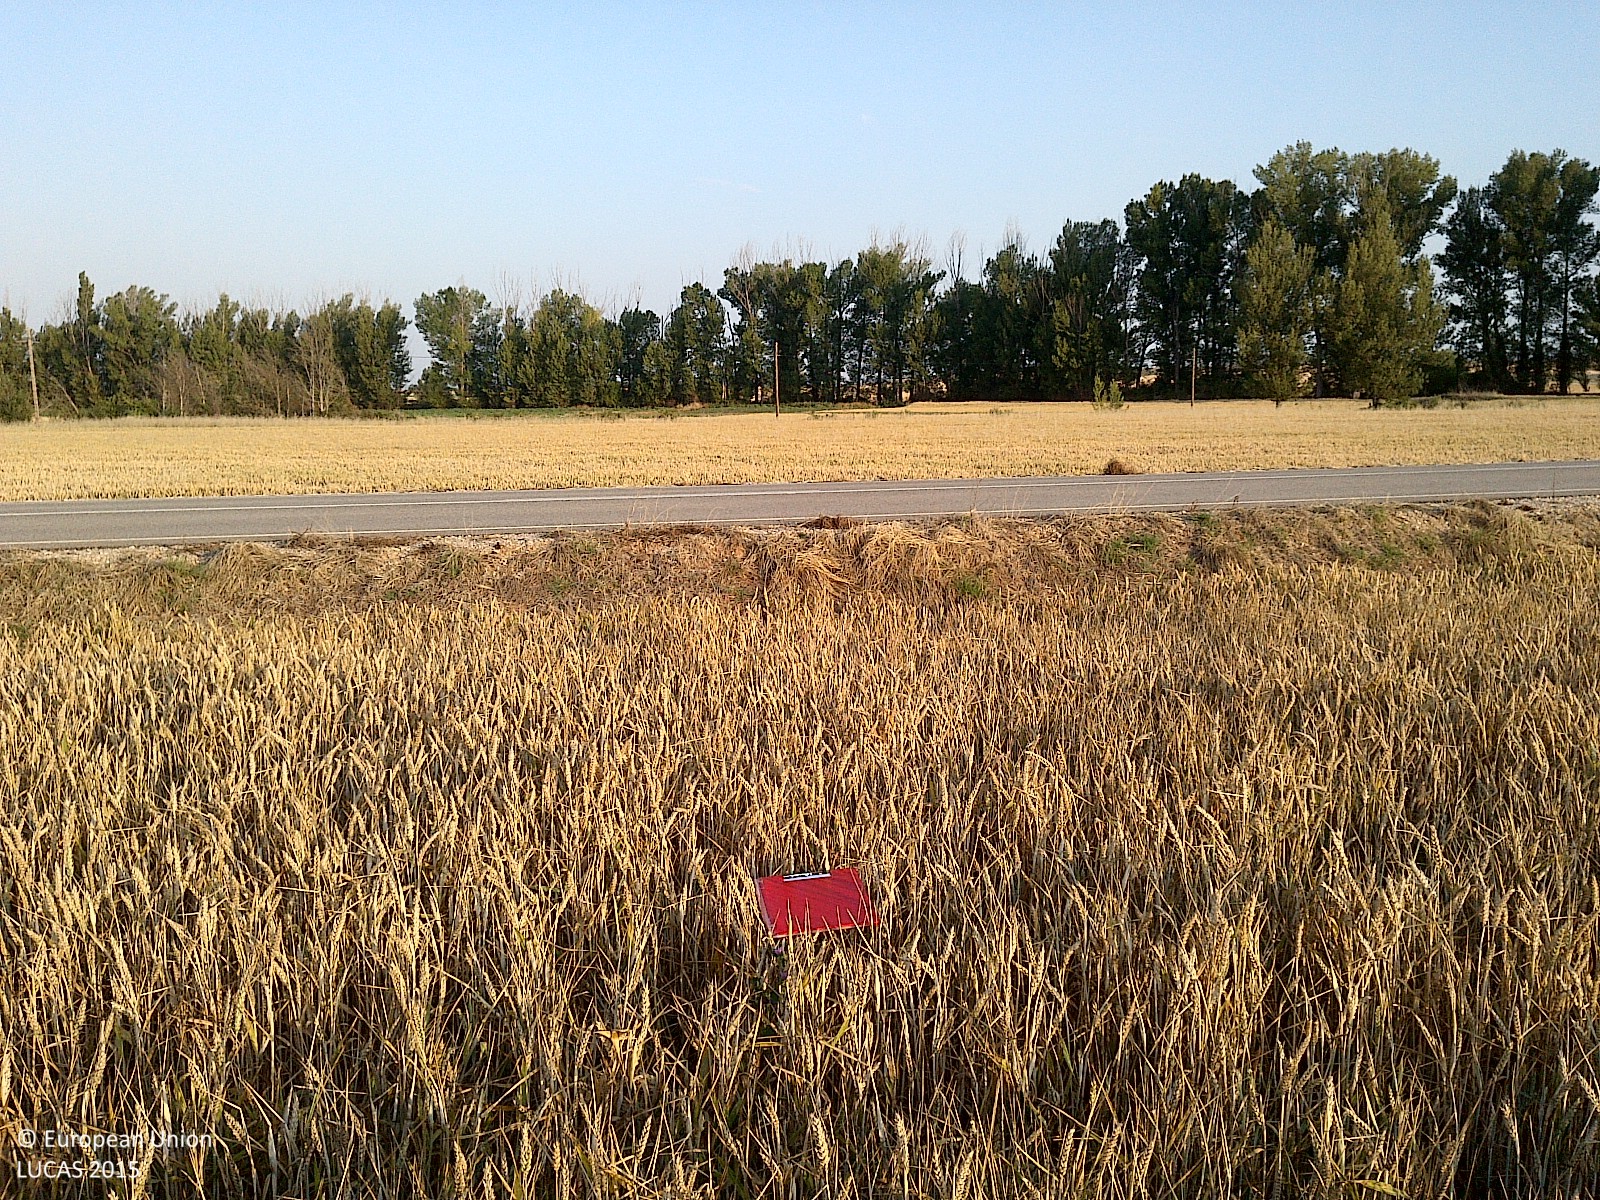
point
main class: Cropland
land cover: Common wheat
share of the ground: > 75 %
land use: Agriculture (excluding fallow land and kitchen gardens)
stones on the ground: < 10 %
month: June
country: ES
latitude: 41.6761
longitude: -2.2023
